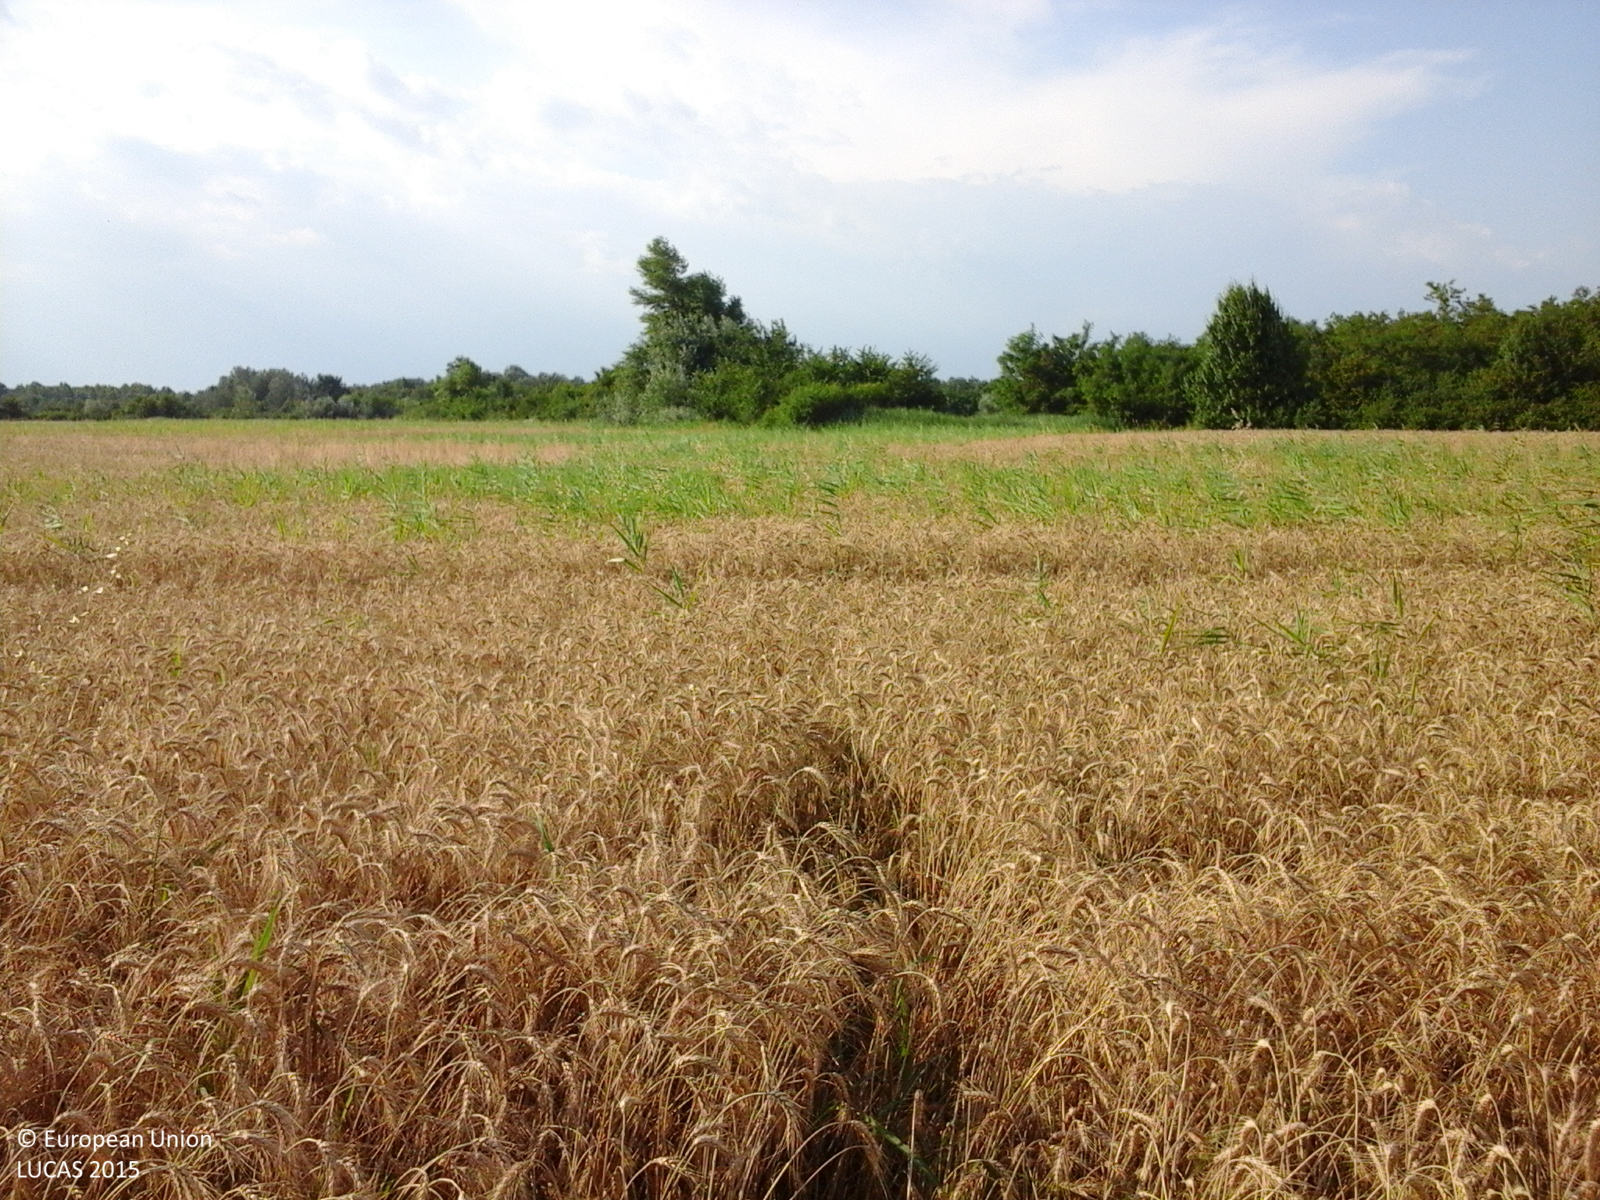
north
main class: Cropland
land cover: Common wheat
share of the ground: > 75 %
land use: Agriculture (excluding fallow land and kitchen gardens)
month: July
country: RO
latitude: 44.1728
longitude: 24.4632
